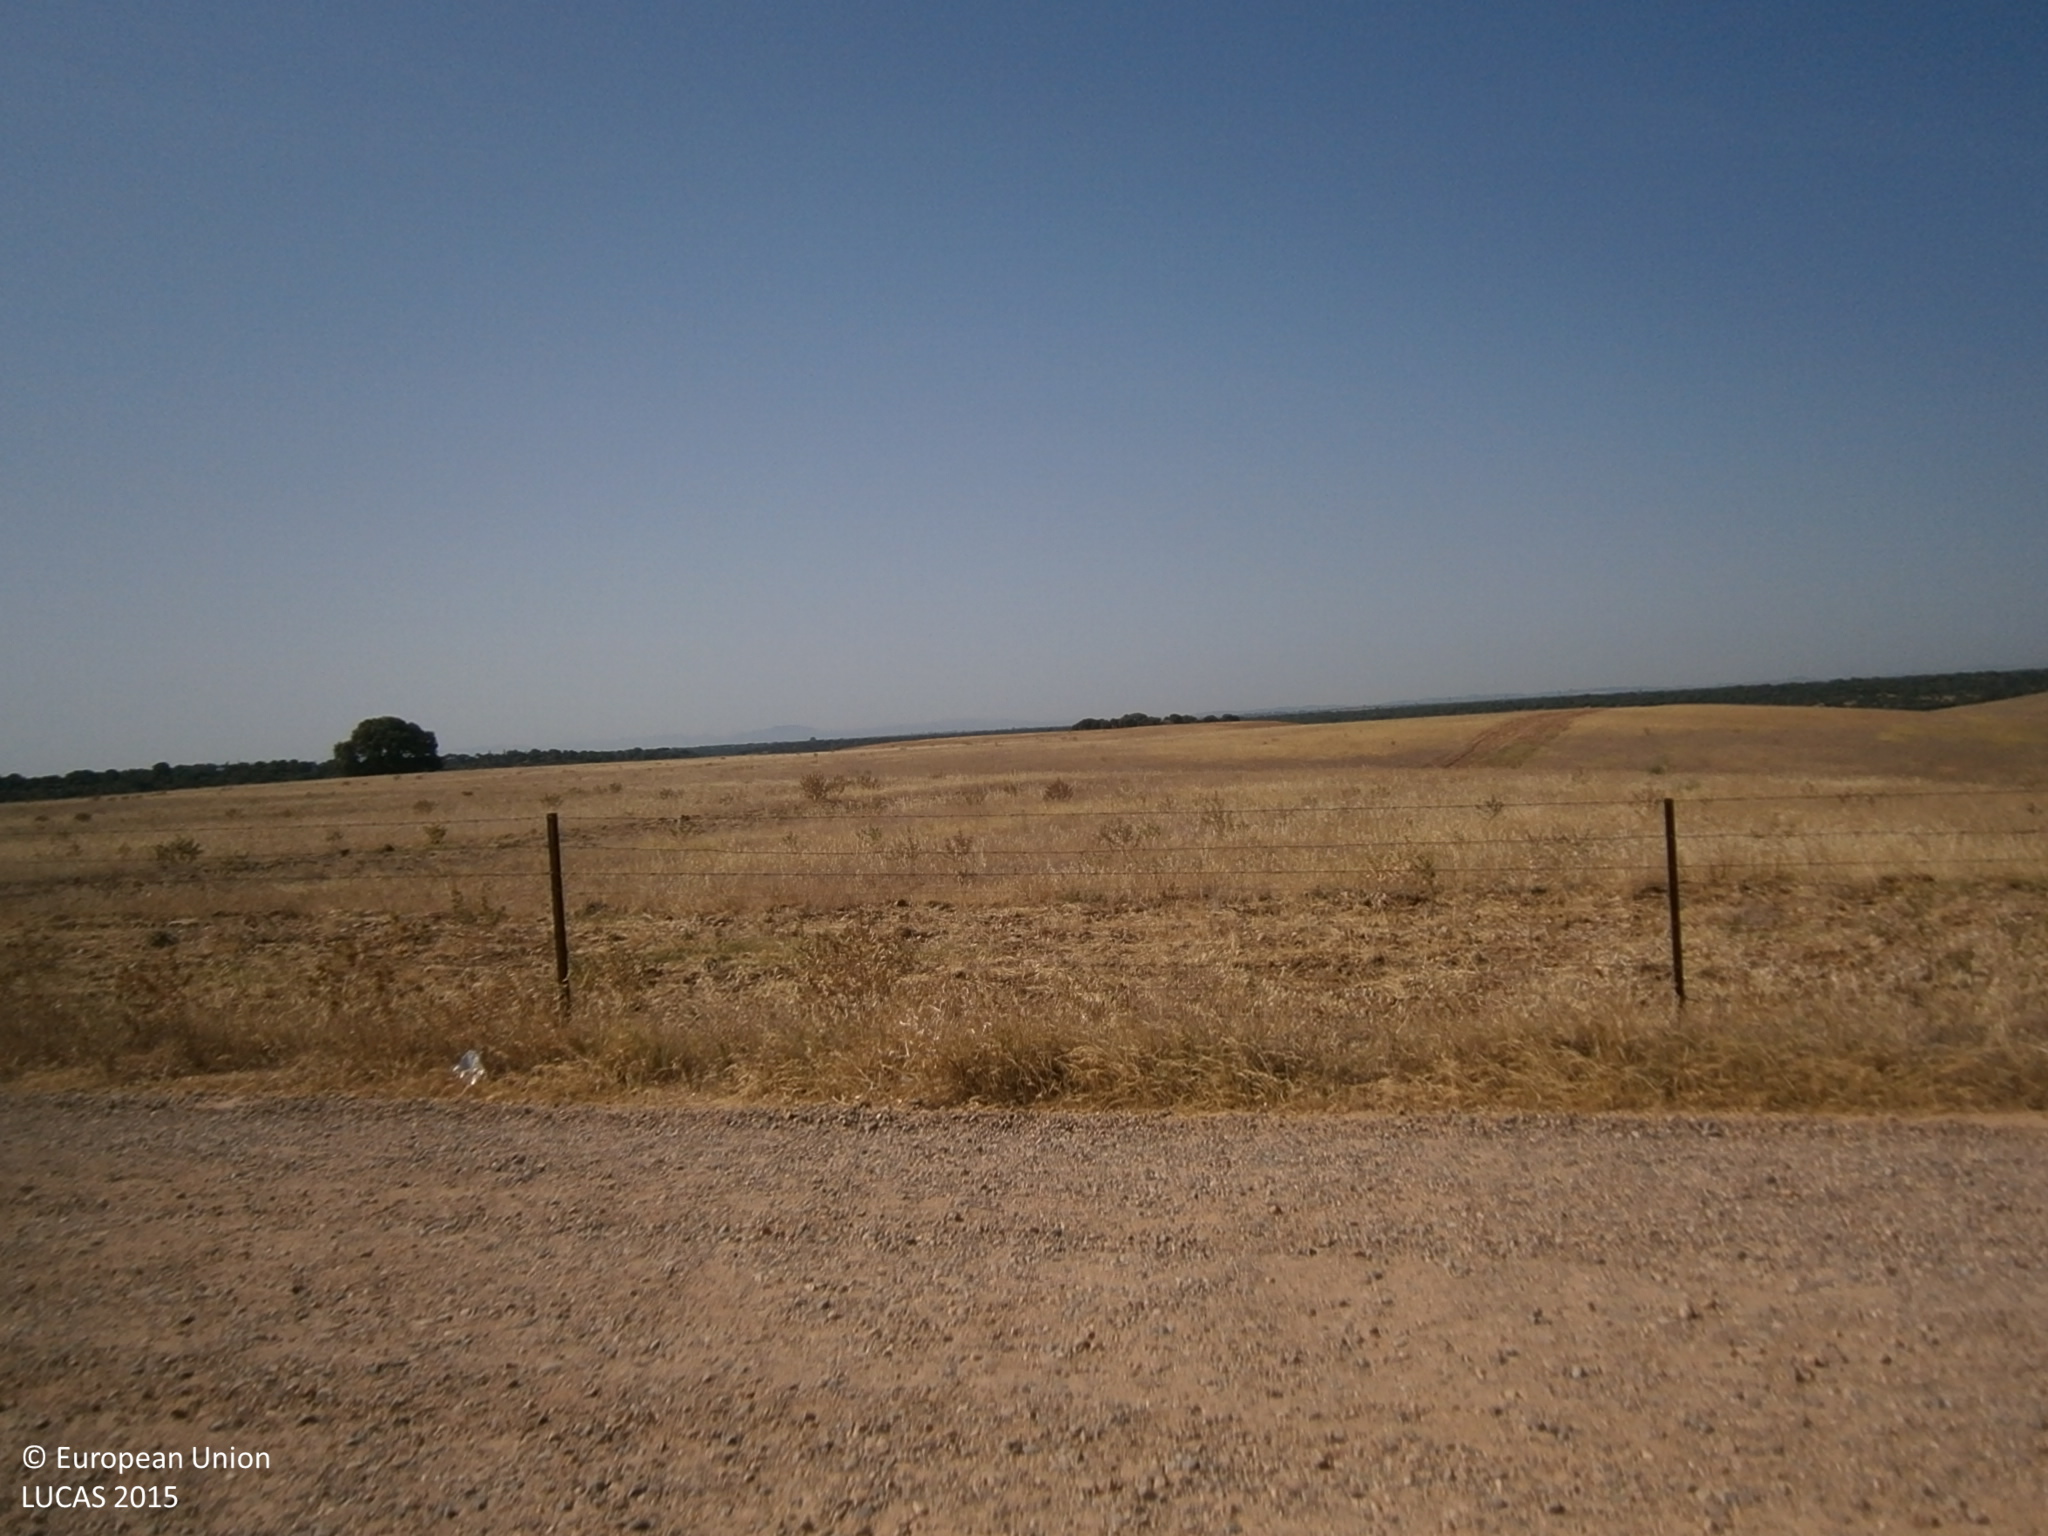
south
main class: Grassland
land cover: Grassland with sparse tree/shrub cover
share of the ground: > 75 %
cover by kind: herbaceous plants 70 %, shrubs 10 %, unconsolidated bare surface 10 %, broadleaved forest trees 5 %
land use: Agriculture (excluding fallow land and kitchen gardens)
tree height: > 5 m
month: July
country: ES
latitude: 38.8797
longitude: -6.9098
